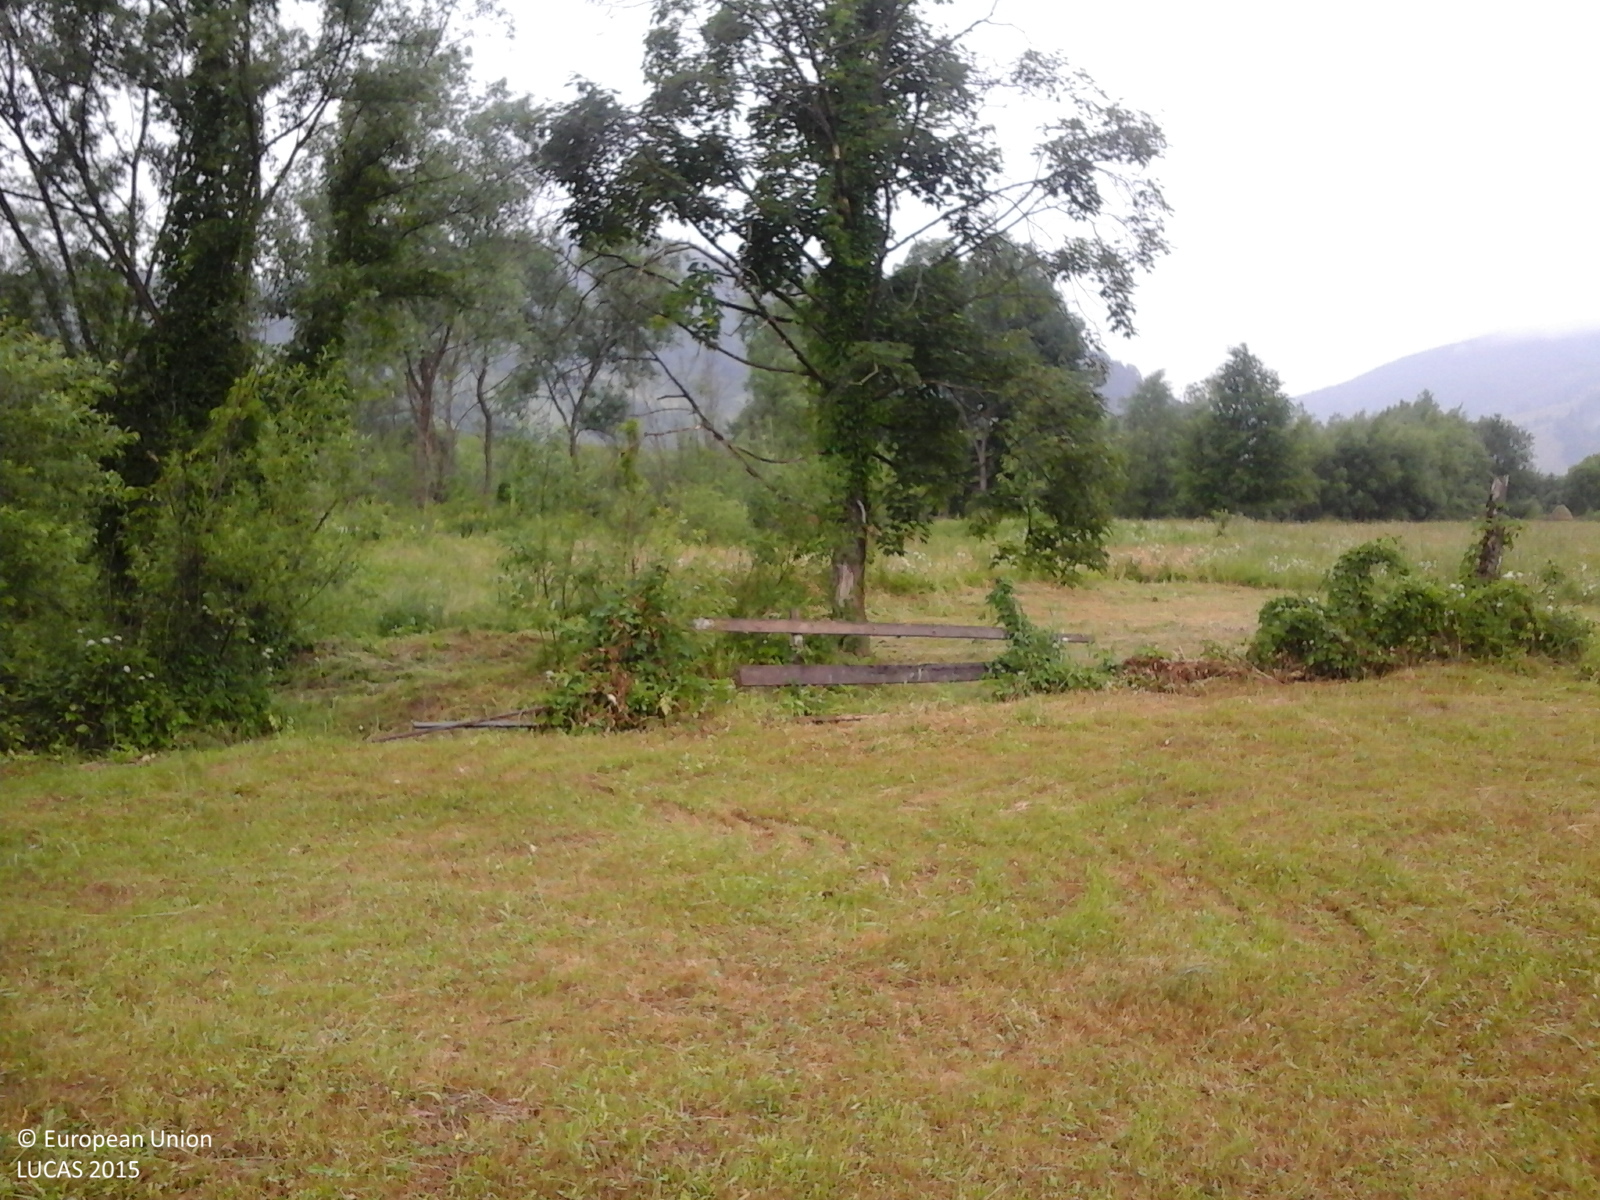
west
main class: Cropland
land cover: Other leguminous and mixtures for fodder
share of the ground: > 75 %
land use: Agriculture (excluding fallow land and kitchen gardens)
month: June
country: RO
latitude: 47.5603
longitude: 25.7386
